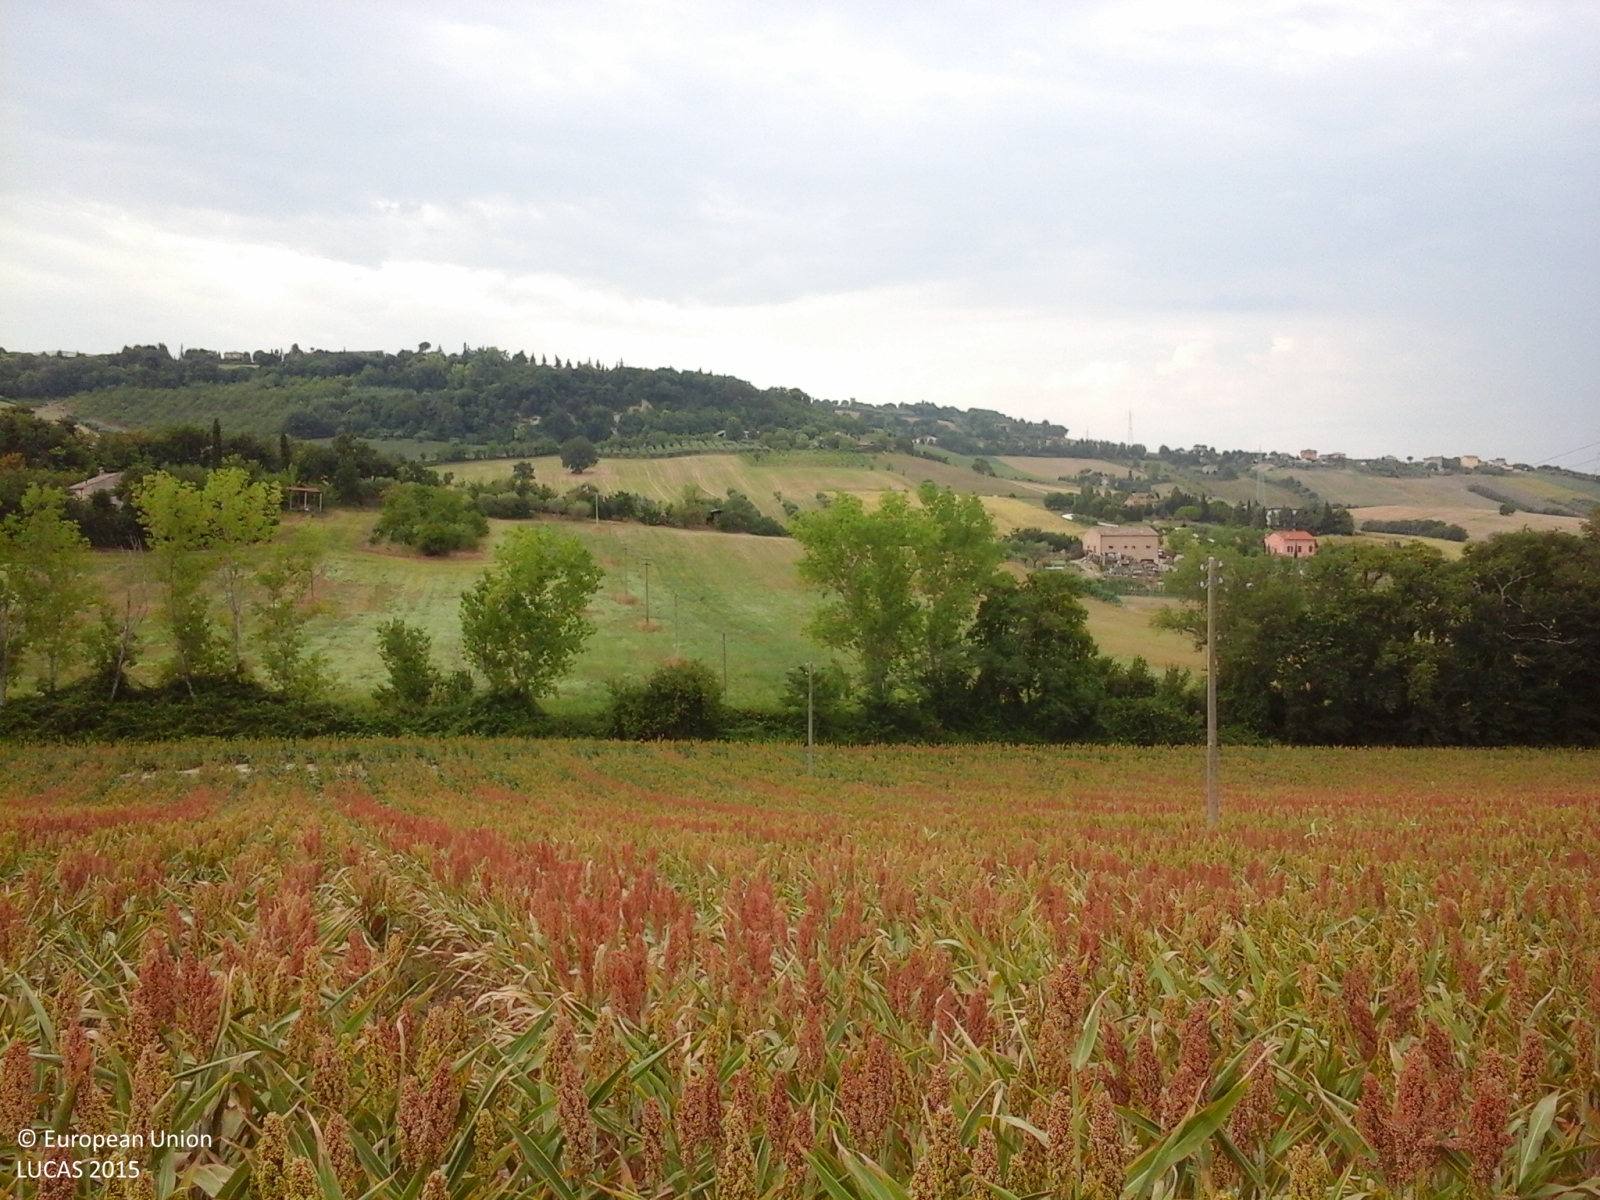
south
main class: Cropland
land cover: Other cereals
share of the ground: > 75 %
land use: Agriculture (excluding fallow land and kitchen gardens)
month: August
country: IT
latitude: 43.3015
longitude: 13.4059
